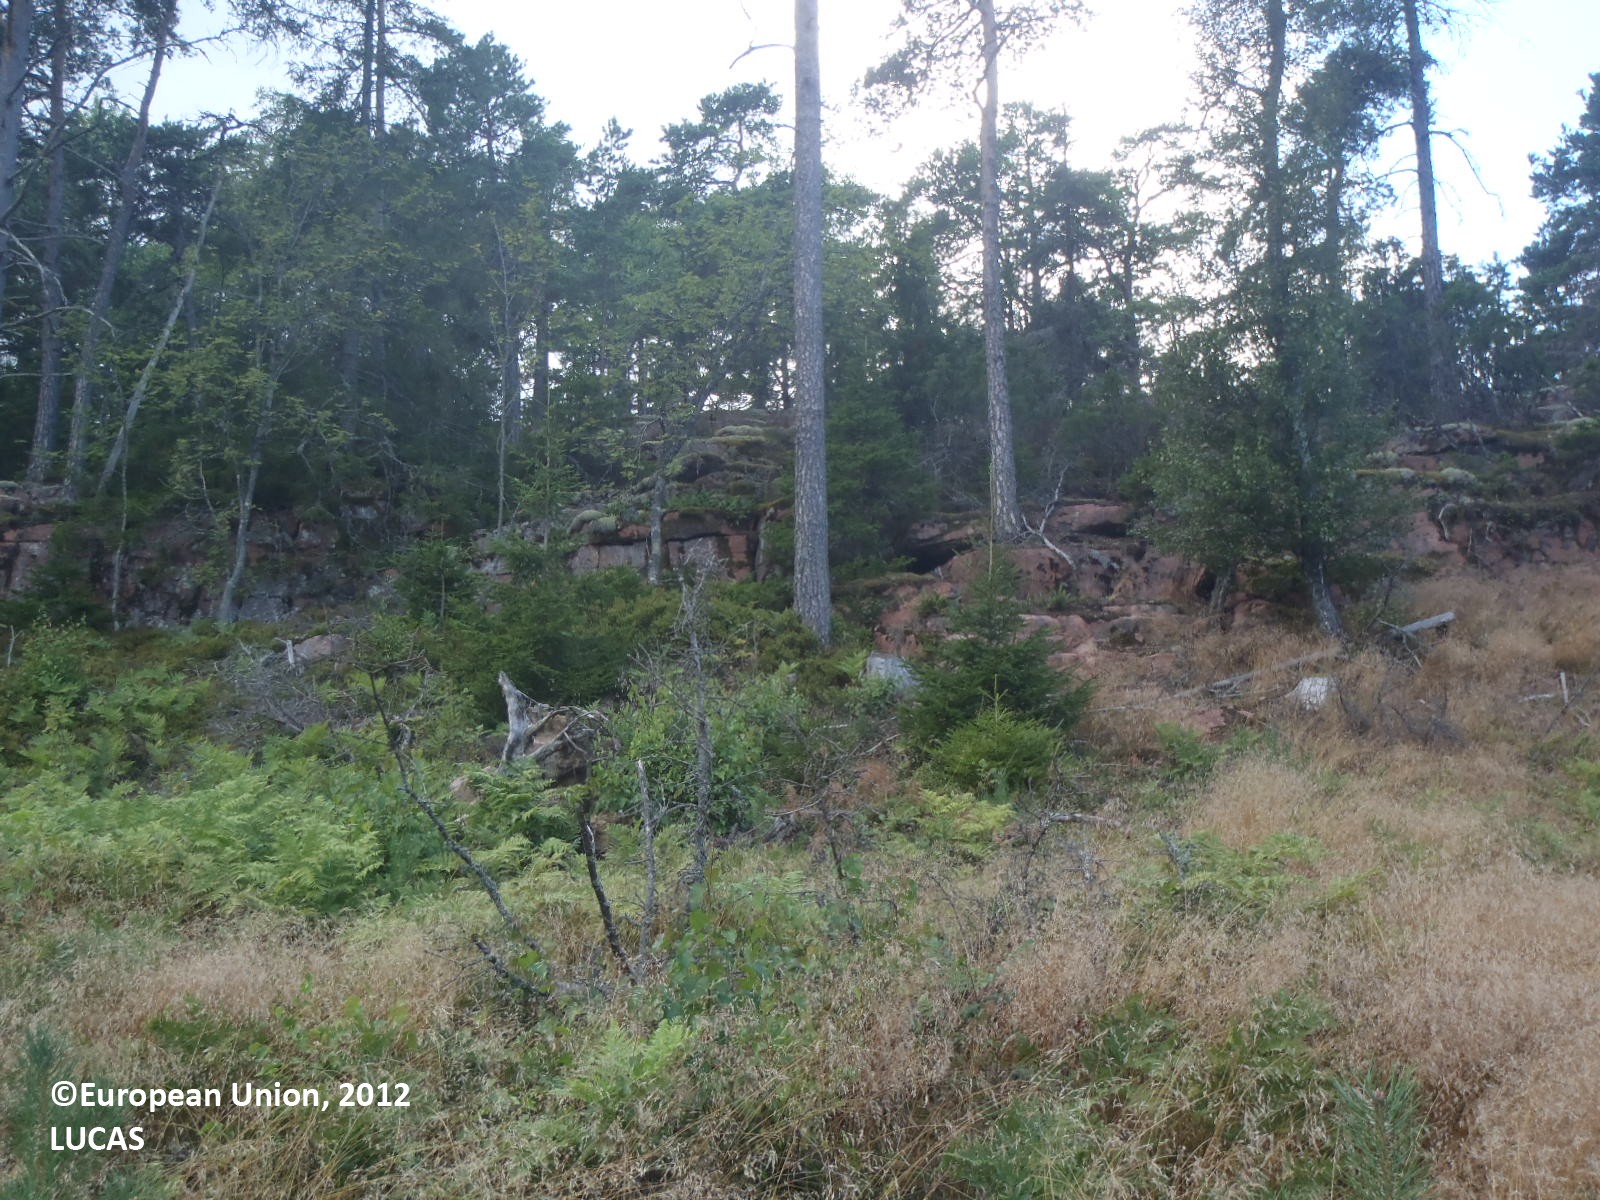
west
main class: Woodland
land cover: Pine dominated coniferous woodland
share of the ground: 10 - 25 %
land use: Forestry
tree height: < 5 m
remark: Clear cut
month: August
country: FI
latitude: 60.3342
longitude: 19.9863
